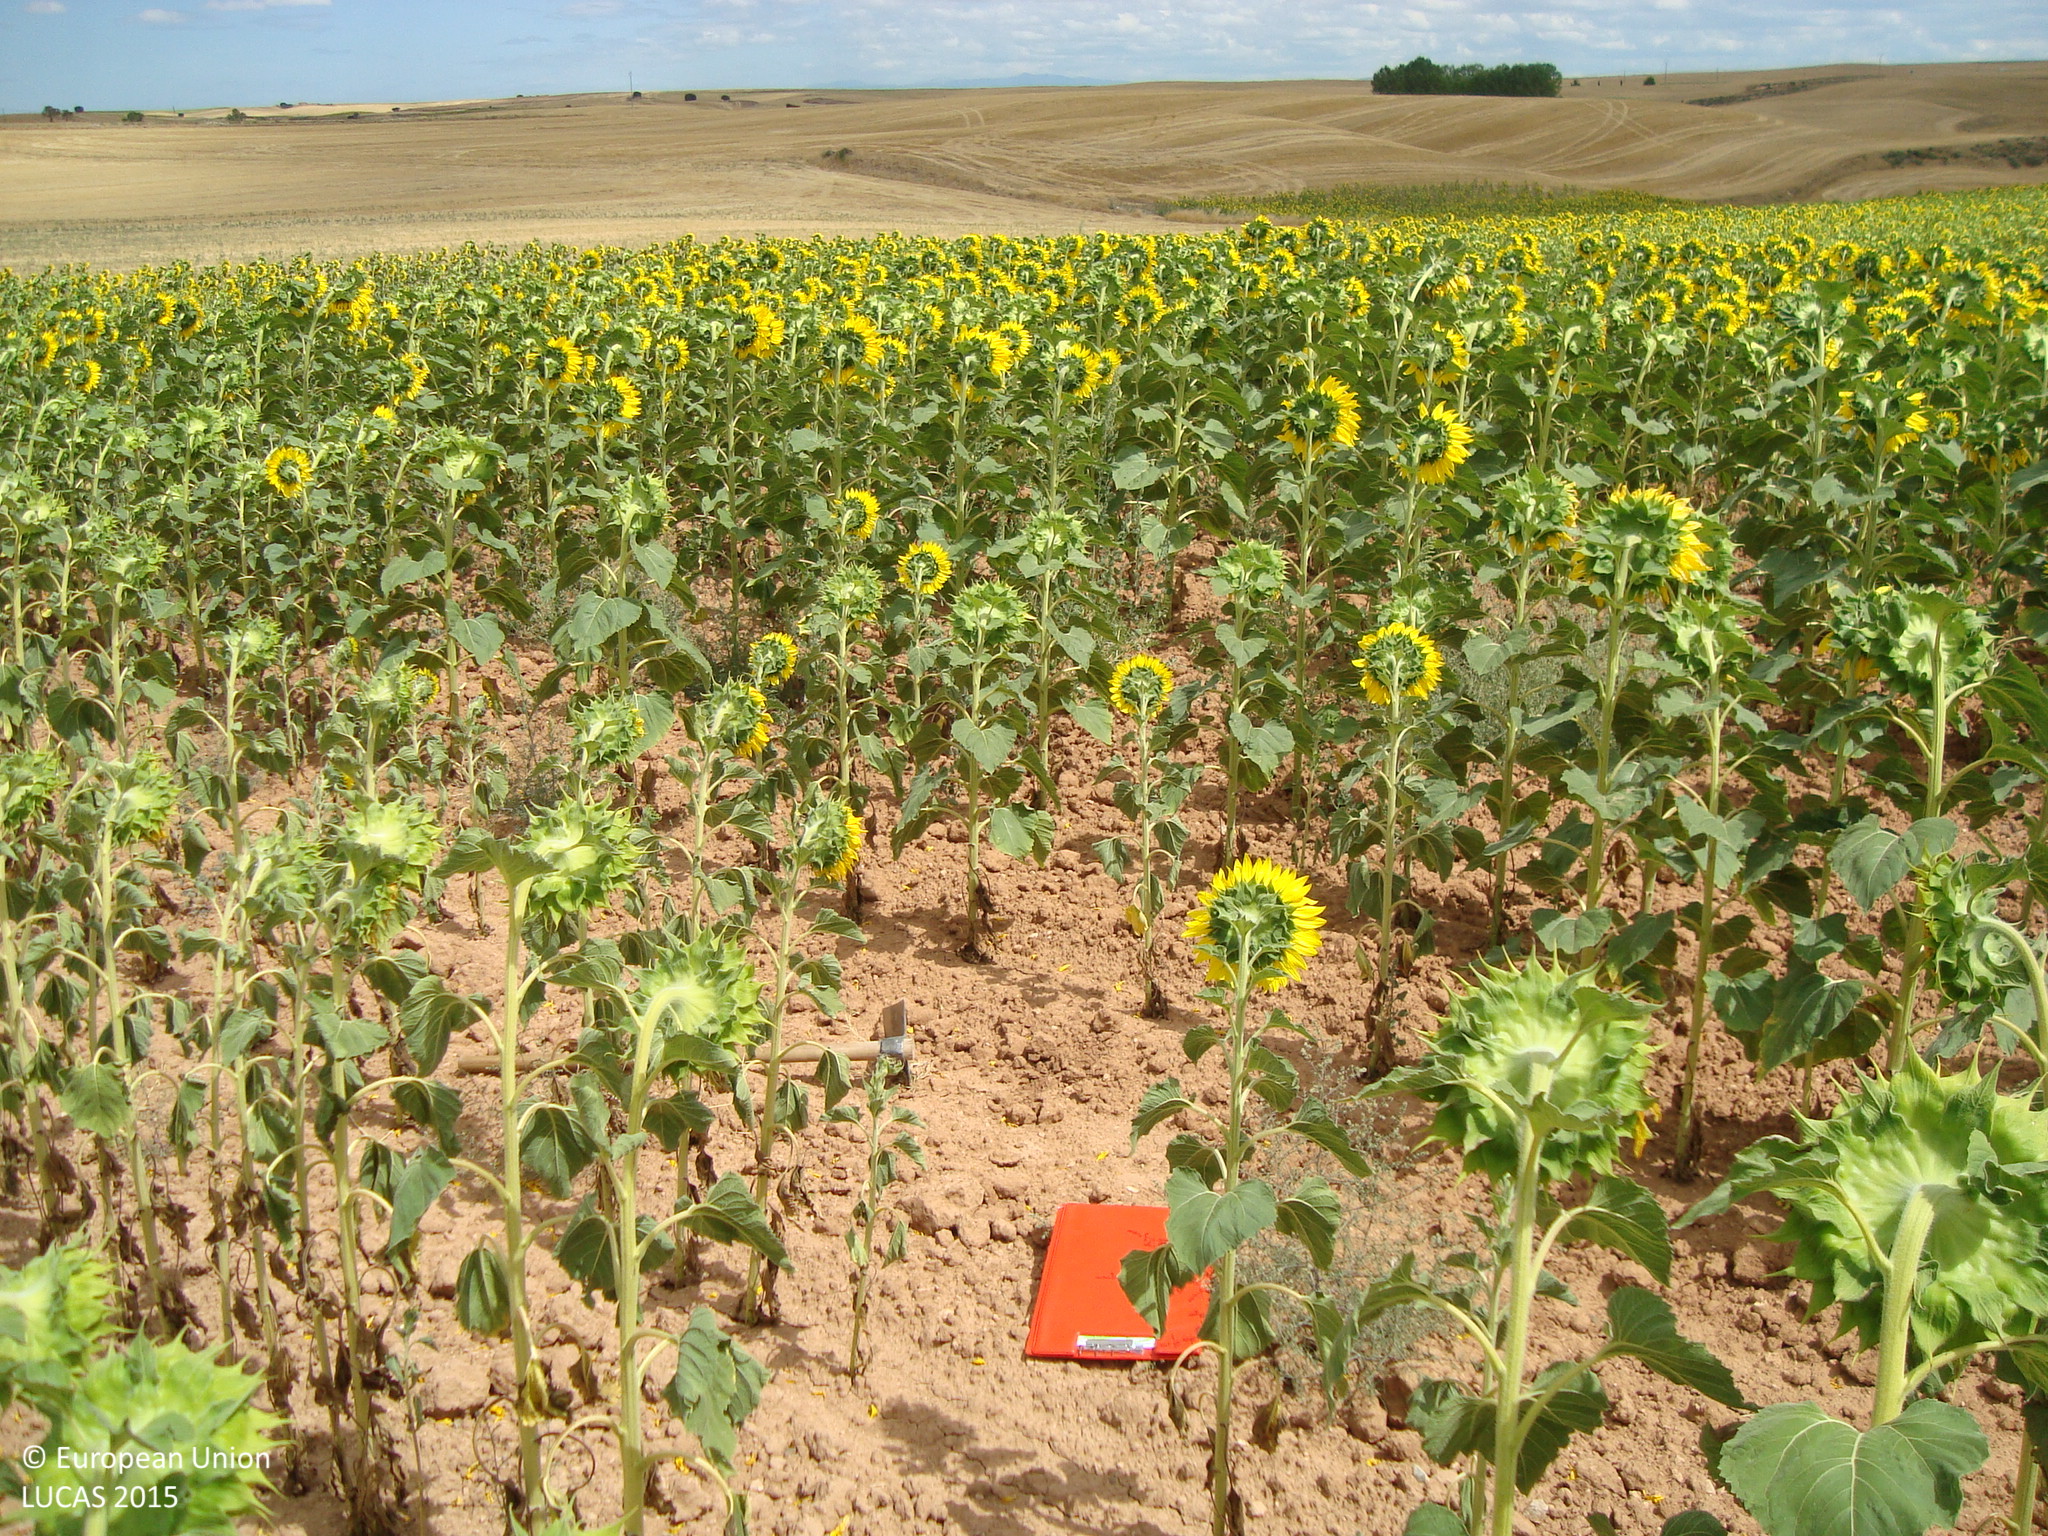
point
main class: Cropland
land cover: Sunflower
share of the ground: > 75 %
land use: Agriculture (excluding fallow land and kitchen gardens)
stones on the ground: < 10 %
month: August
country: ES
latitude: 42.0569
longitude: -3.8960
